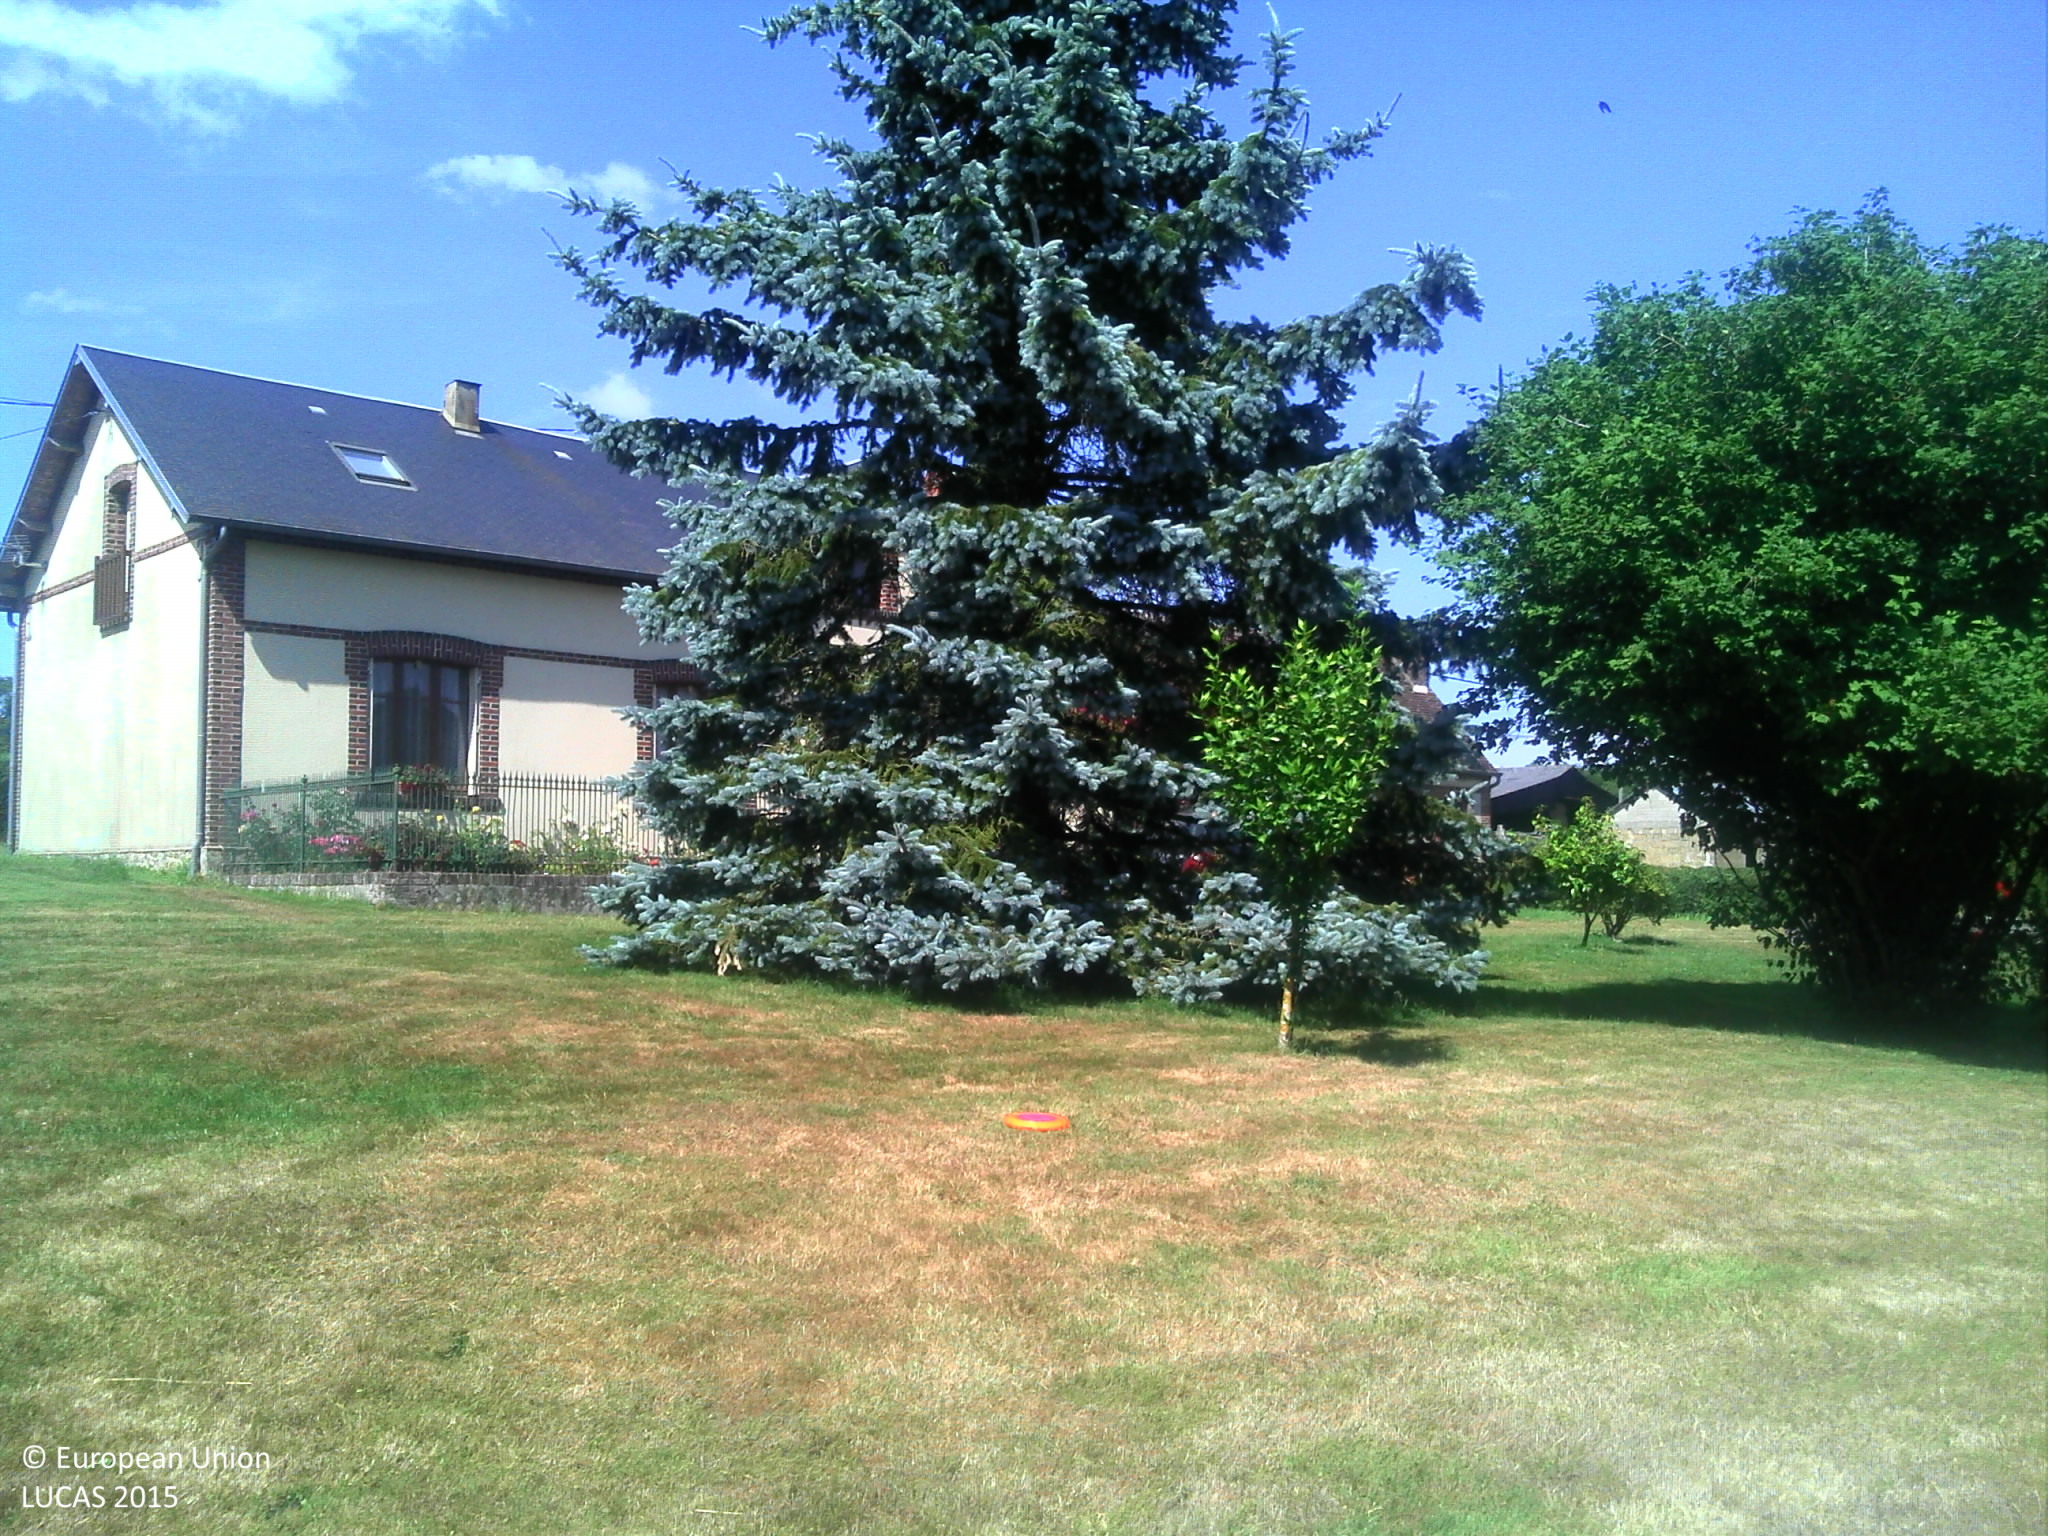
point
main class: Grassland
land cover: Grassland with sparse tree/shrub cover
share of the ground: > 75 %
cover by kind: herbaceous plants 90 %, coniferous forest trees 5 %, shrubs 5 %
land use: Residential
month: July
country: FR
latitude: 48.7361
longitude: 0.4975
